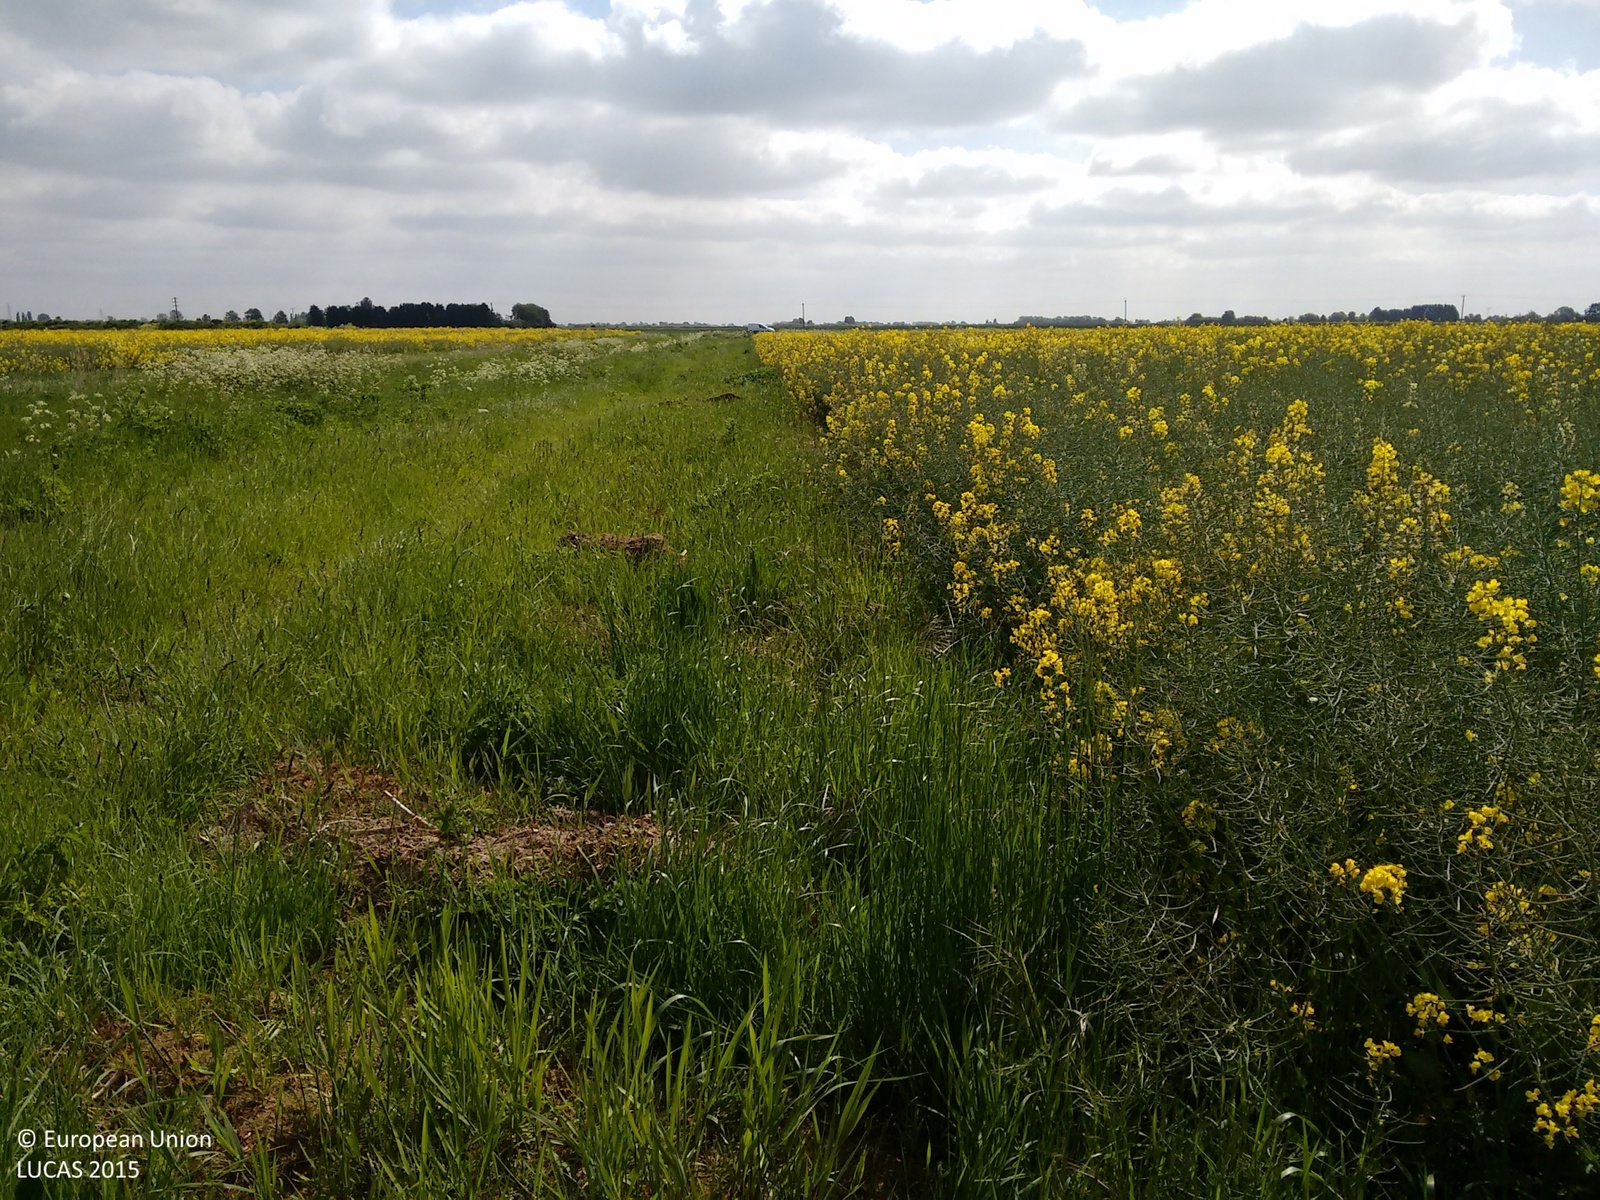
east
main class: Cropland
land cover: Rape and turnip rape
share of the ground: > 75 %
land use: Agriculture (excluding fallow land and kitchen gardens)
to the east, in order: Rape and turnip rape; Grass margins; Tracks; Grass margins; Ditches and canals; Grass margins; Common wheat
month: May
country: GB
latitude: 52.7462
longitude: -0.0620
